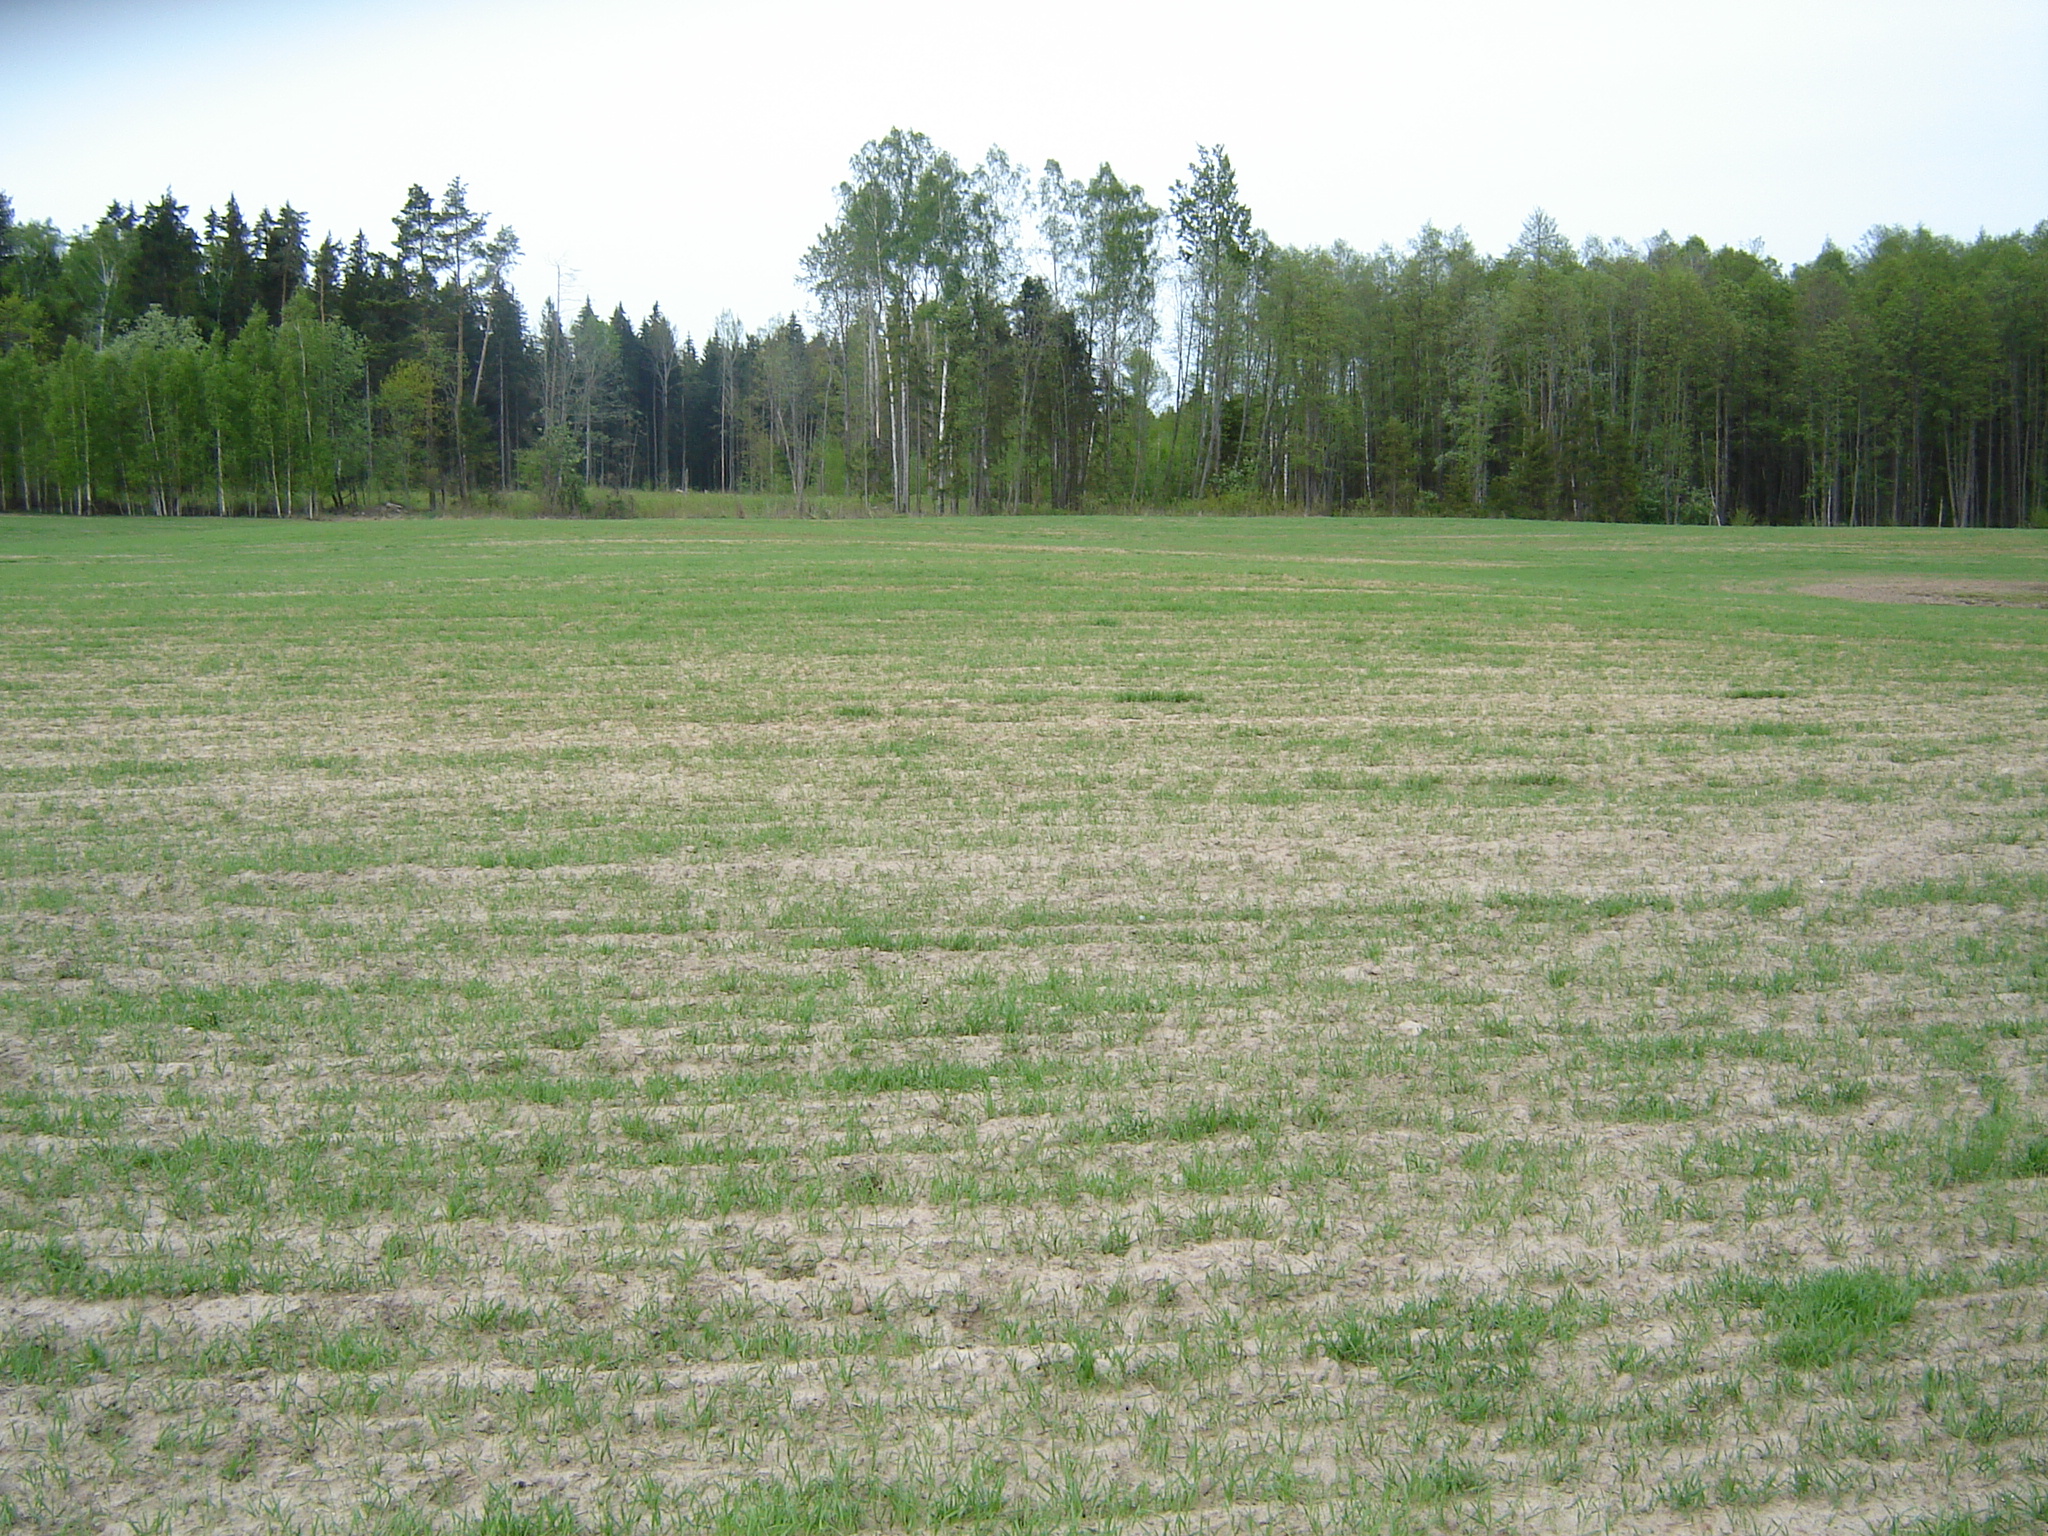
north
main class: Cropland
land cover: Common wheat
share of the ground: 25 - 50 %
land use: Agriculture (excluding fallow land and kitchen gardens)
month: May
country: LT
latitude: 55.8622
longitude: 25.6412
